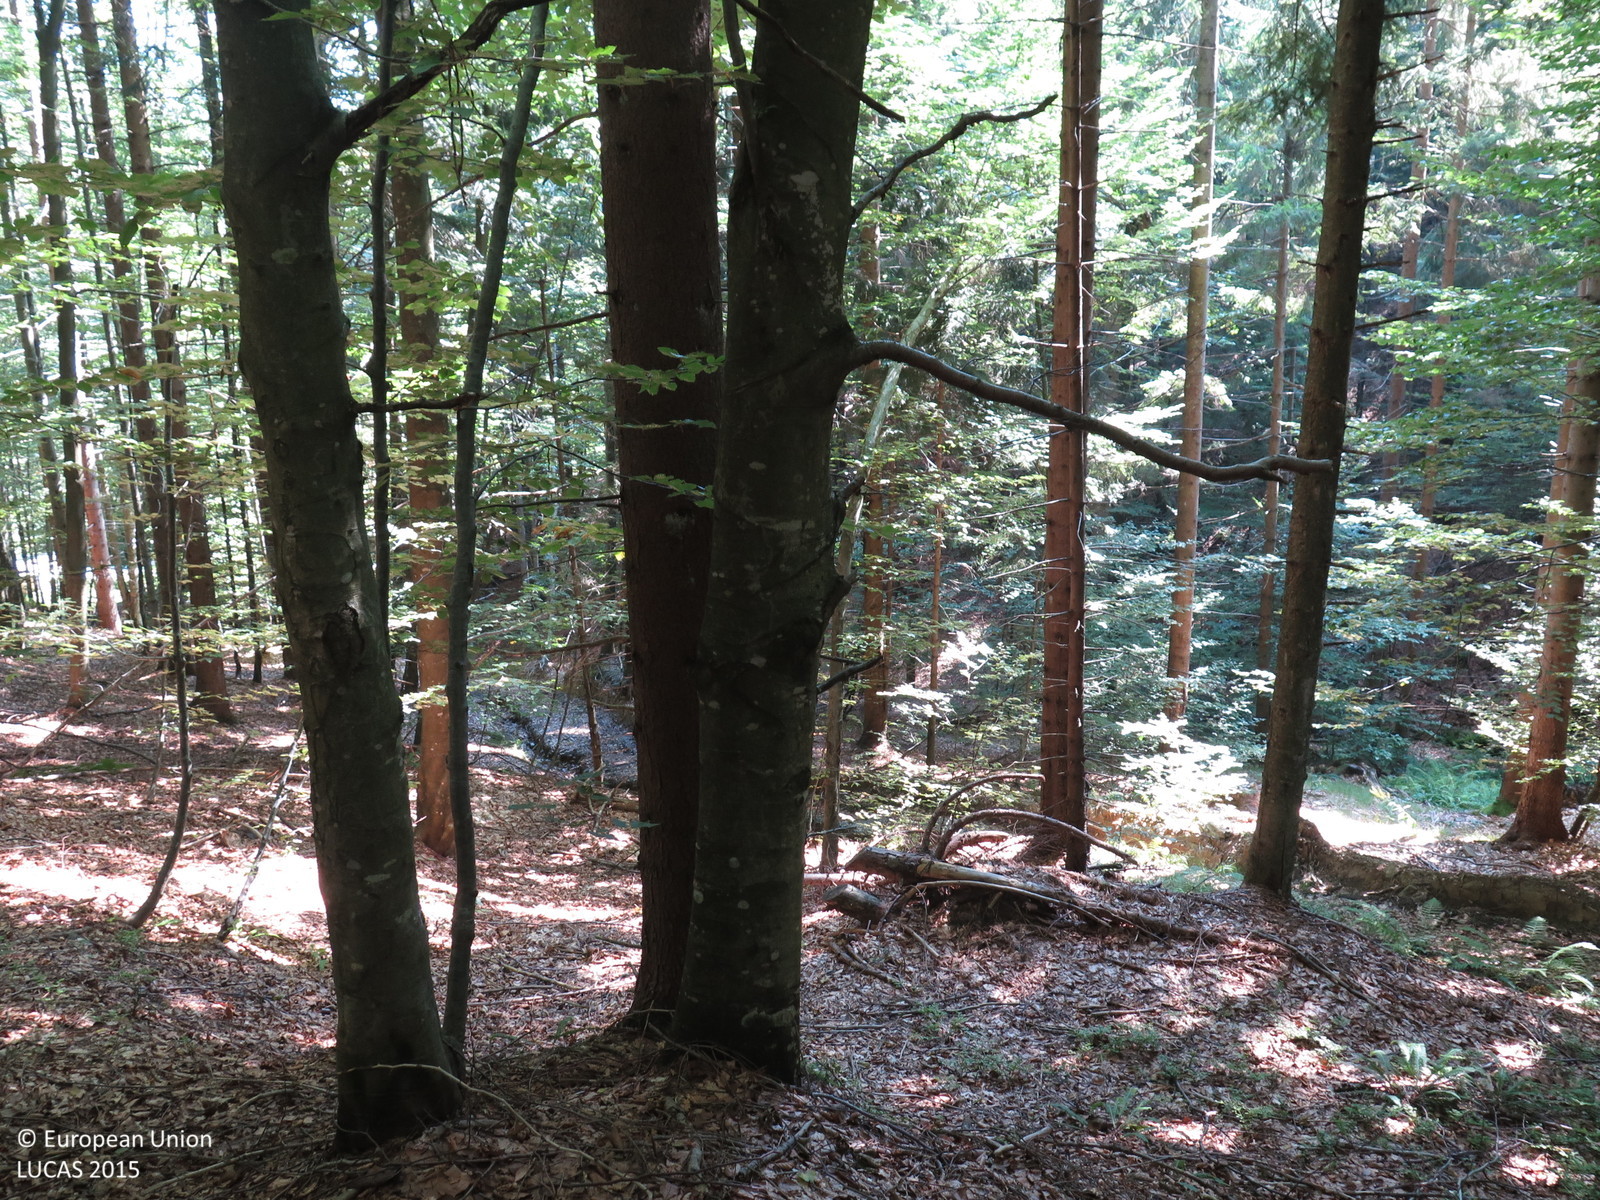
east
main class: Woodland
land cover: Other mixed woodland
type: beech forest
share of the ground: > 75 %
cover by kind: broadleaved forest trees 75 %, coniferous forest trees 25 %
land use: Forestry
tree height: > 5 m
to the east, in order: Other mixed woodland; Inland fresh running water; Other mixed woodland; Inland fresh running water; Broadleaved woodland; Tracks; Other mixed woodland; Inland fresh running water; Other mixed woodland
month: August
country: HR
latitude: 45.3877
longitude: 14.9638
